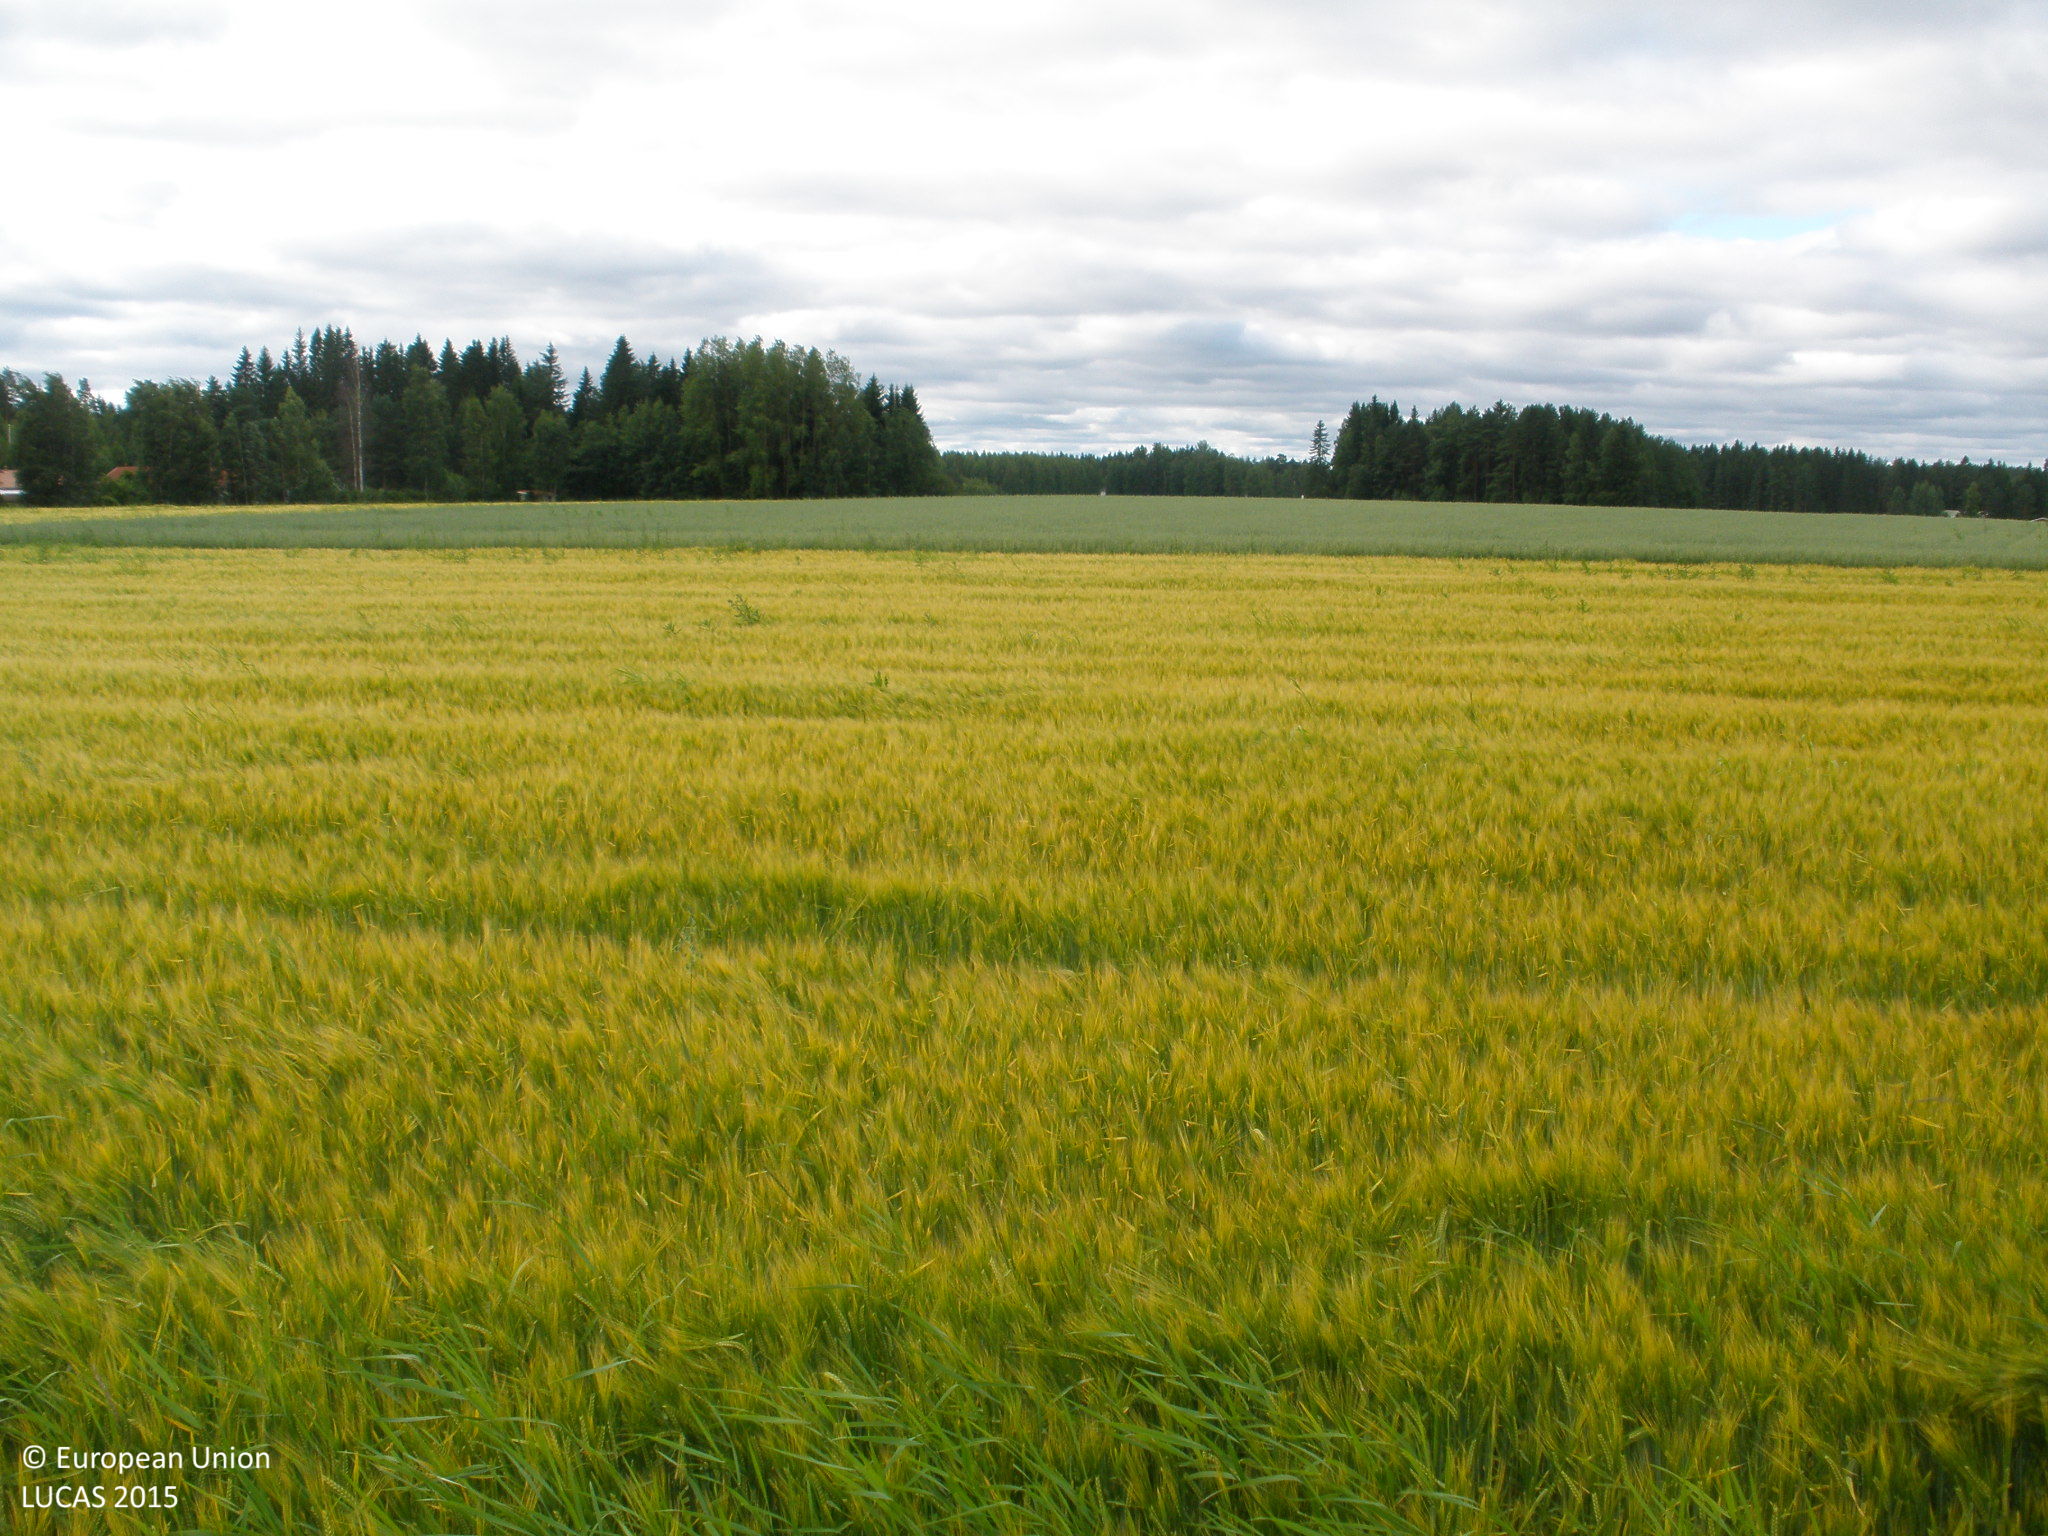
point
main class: Cropland
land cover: Oats
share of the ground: 50 - 75 %
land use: Agriculture (excluding fallow land and kitchen gardens)
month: August
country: FI
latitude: 60.9758
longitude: 24.4206
